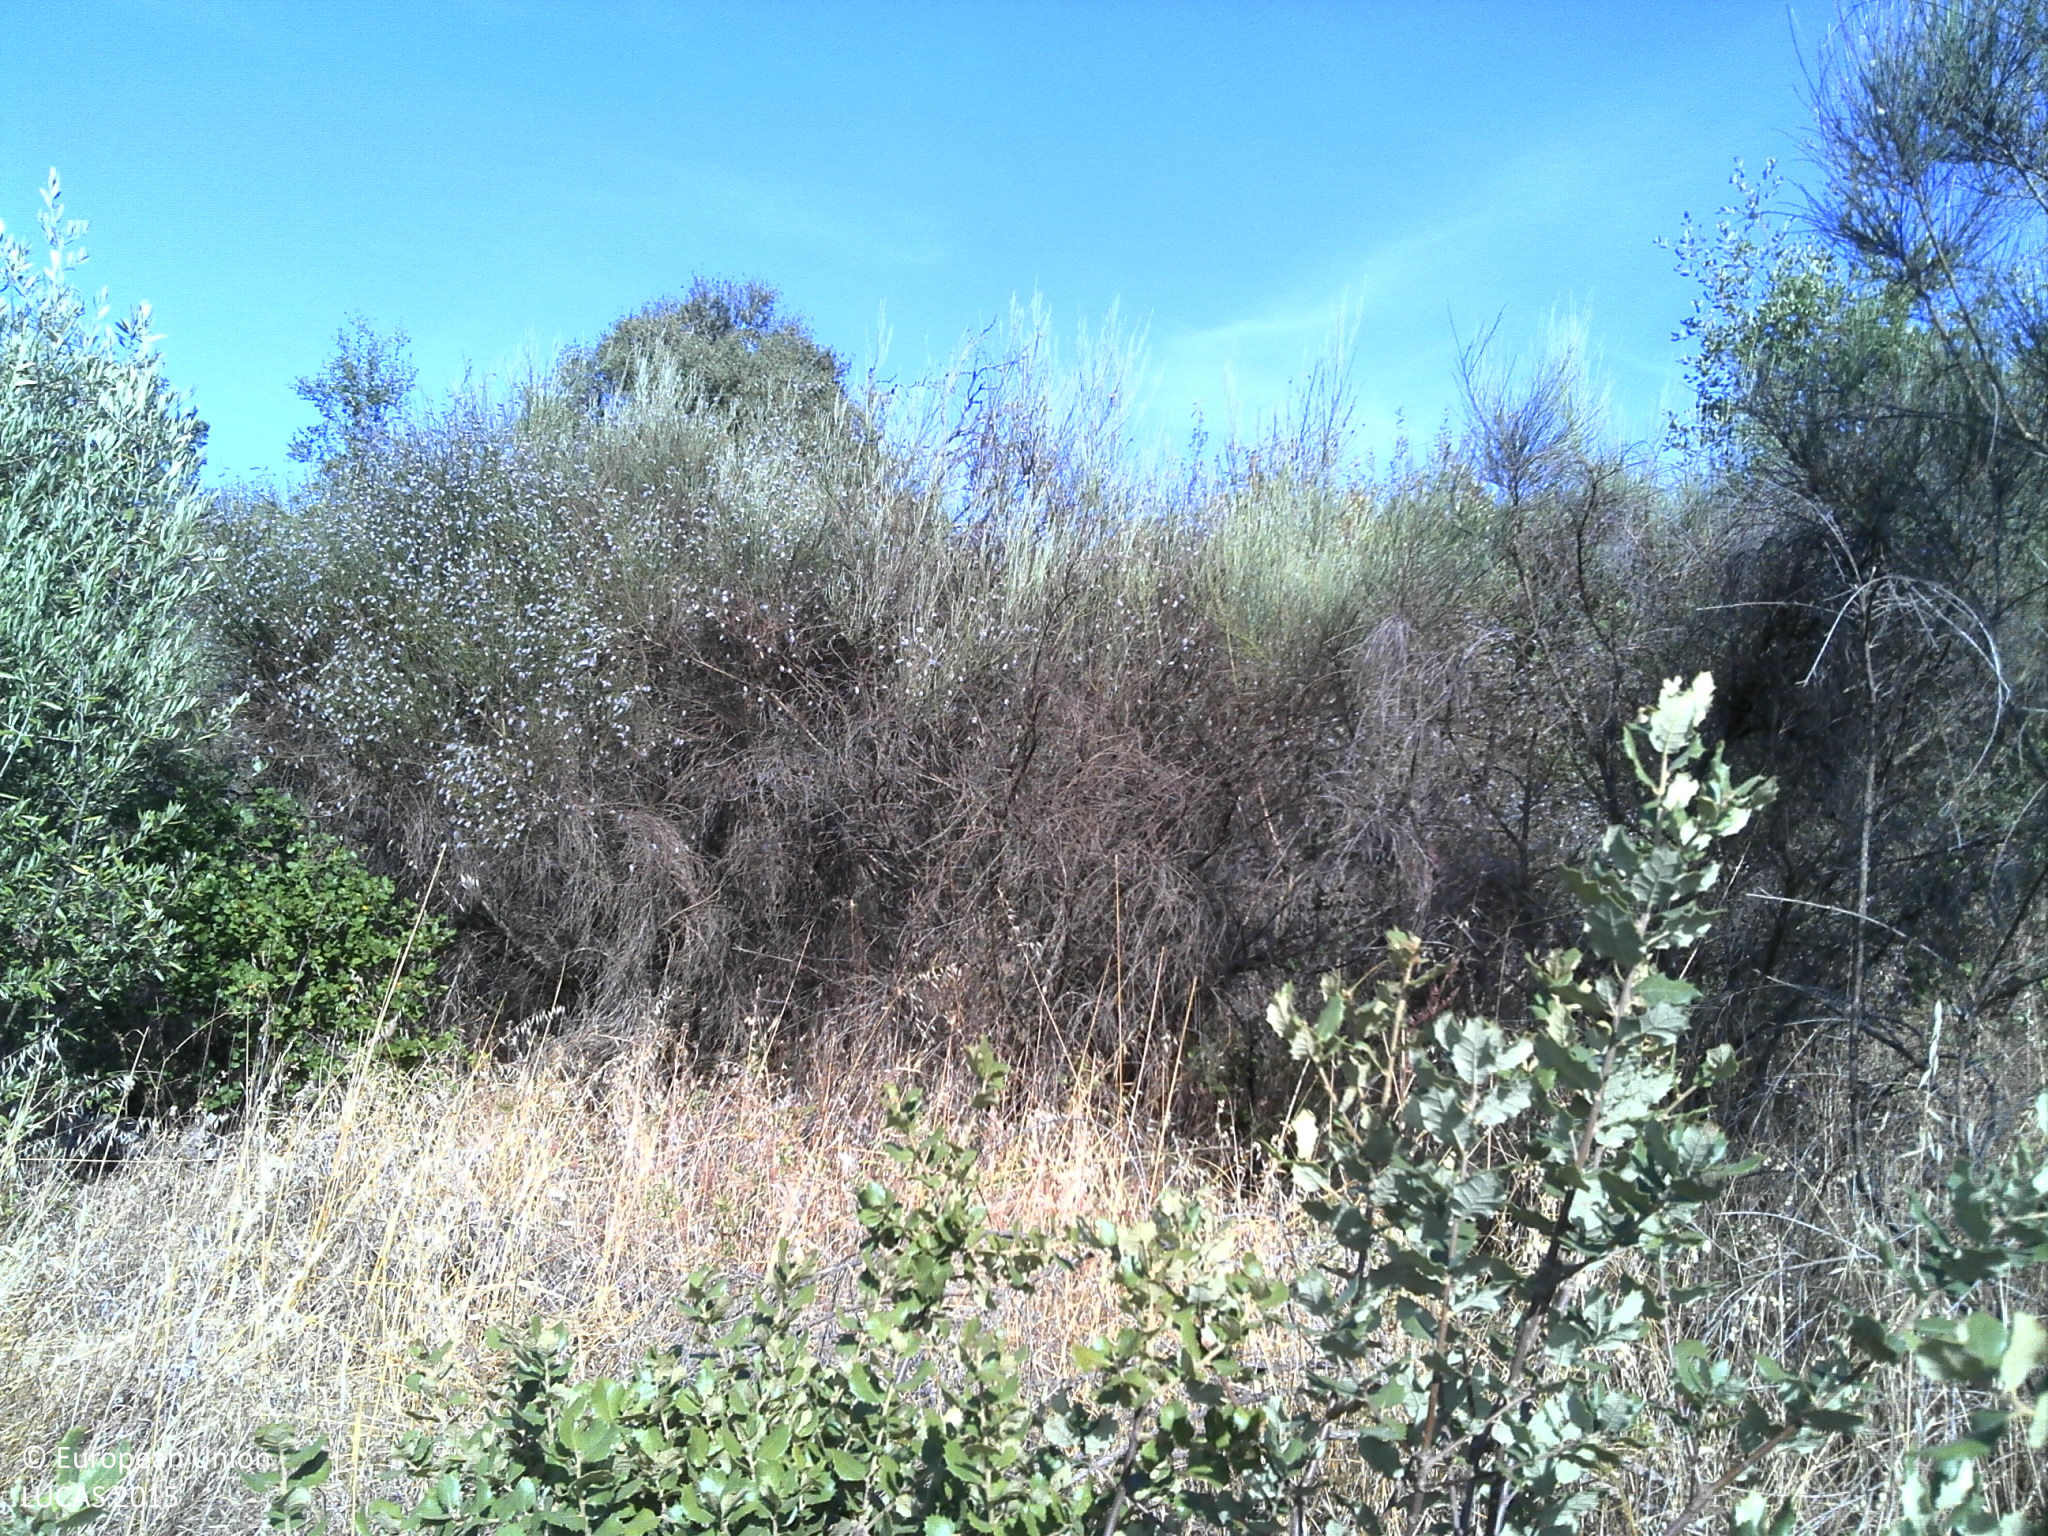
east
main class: Shrubland
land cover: Shrubland with sparse tree cover
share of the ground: > 75 %
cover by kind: shrubs 80 %, herbaceous plants 10 %, broadleaved forest trees 5 %, unconsolidated bare surface 5 %
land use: Semi-natural and natural areas not in use
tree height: < 5 m
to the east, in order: Shrubland with sparse tree cover; Dry stone walls; Broadleaved woodland; Other bare soil; Tracks; Other bare soil; Broadleaved woodland; Other bare soil; Tracks; Shruby margins; Electric lines; Tracks; Shruby margins; Dry stone walls; Broadleaved woodland
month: July
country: PT
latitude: 39.6268
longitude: -7.7757
